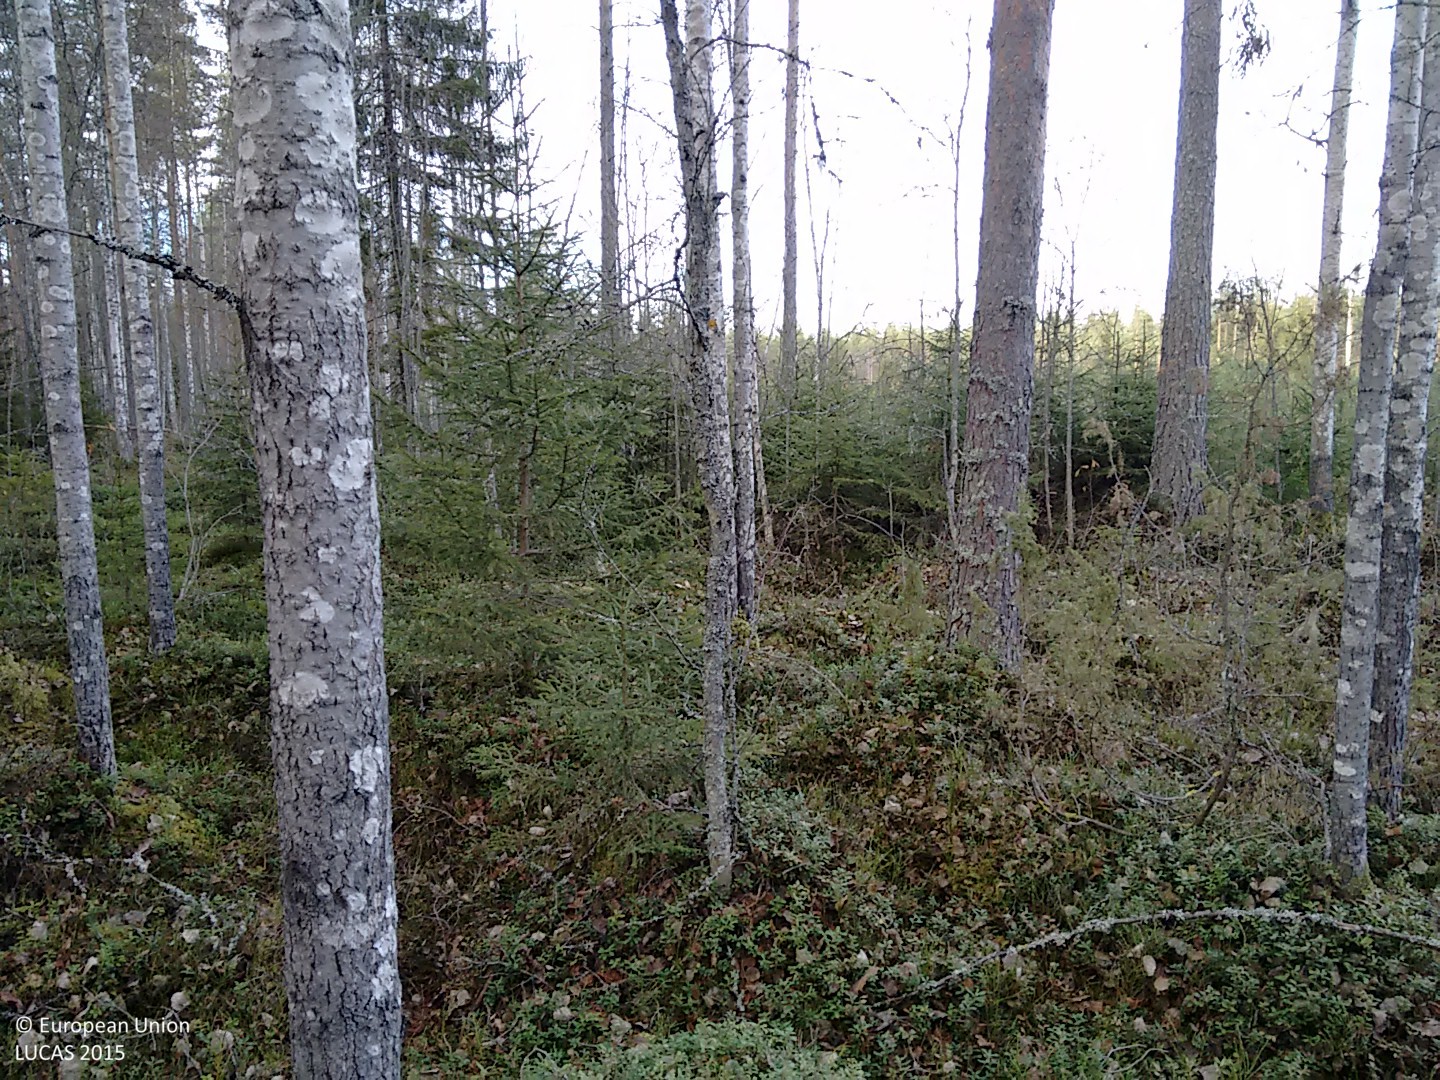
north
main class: Woodland
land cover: Pine dominated mixed woodland
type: boreal forest
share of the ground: > 75 %
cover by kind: broadleaved forest trees 45 %, coniferous forest trees 40 %, shrubs 10 %, herbaceous plants 5 %
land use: Forestry
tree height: > 5 m
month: October
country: FI
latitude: 63.9264
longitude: 25.1172
